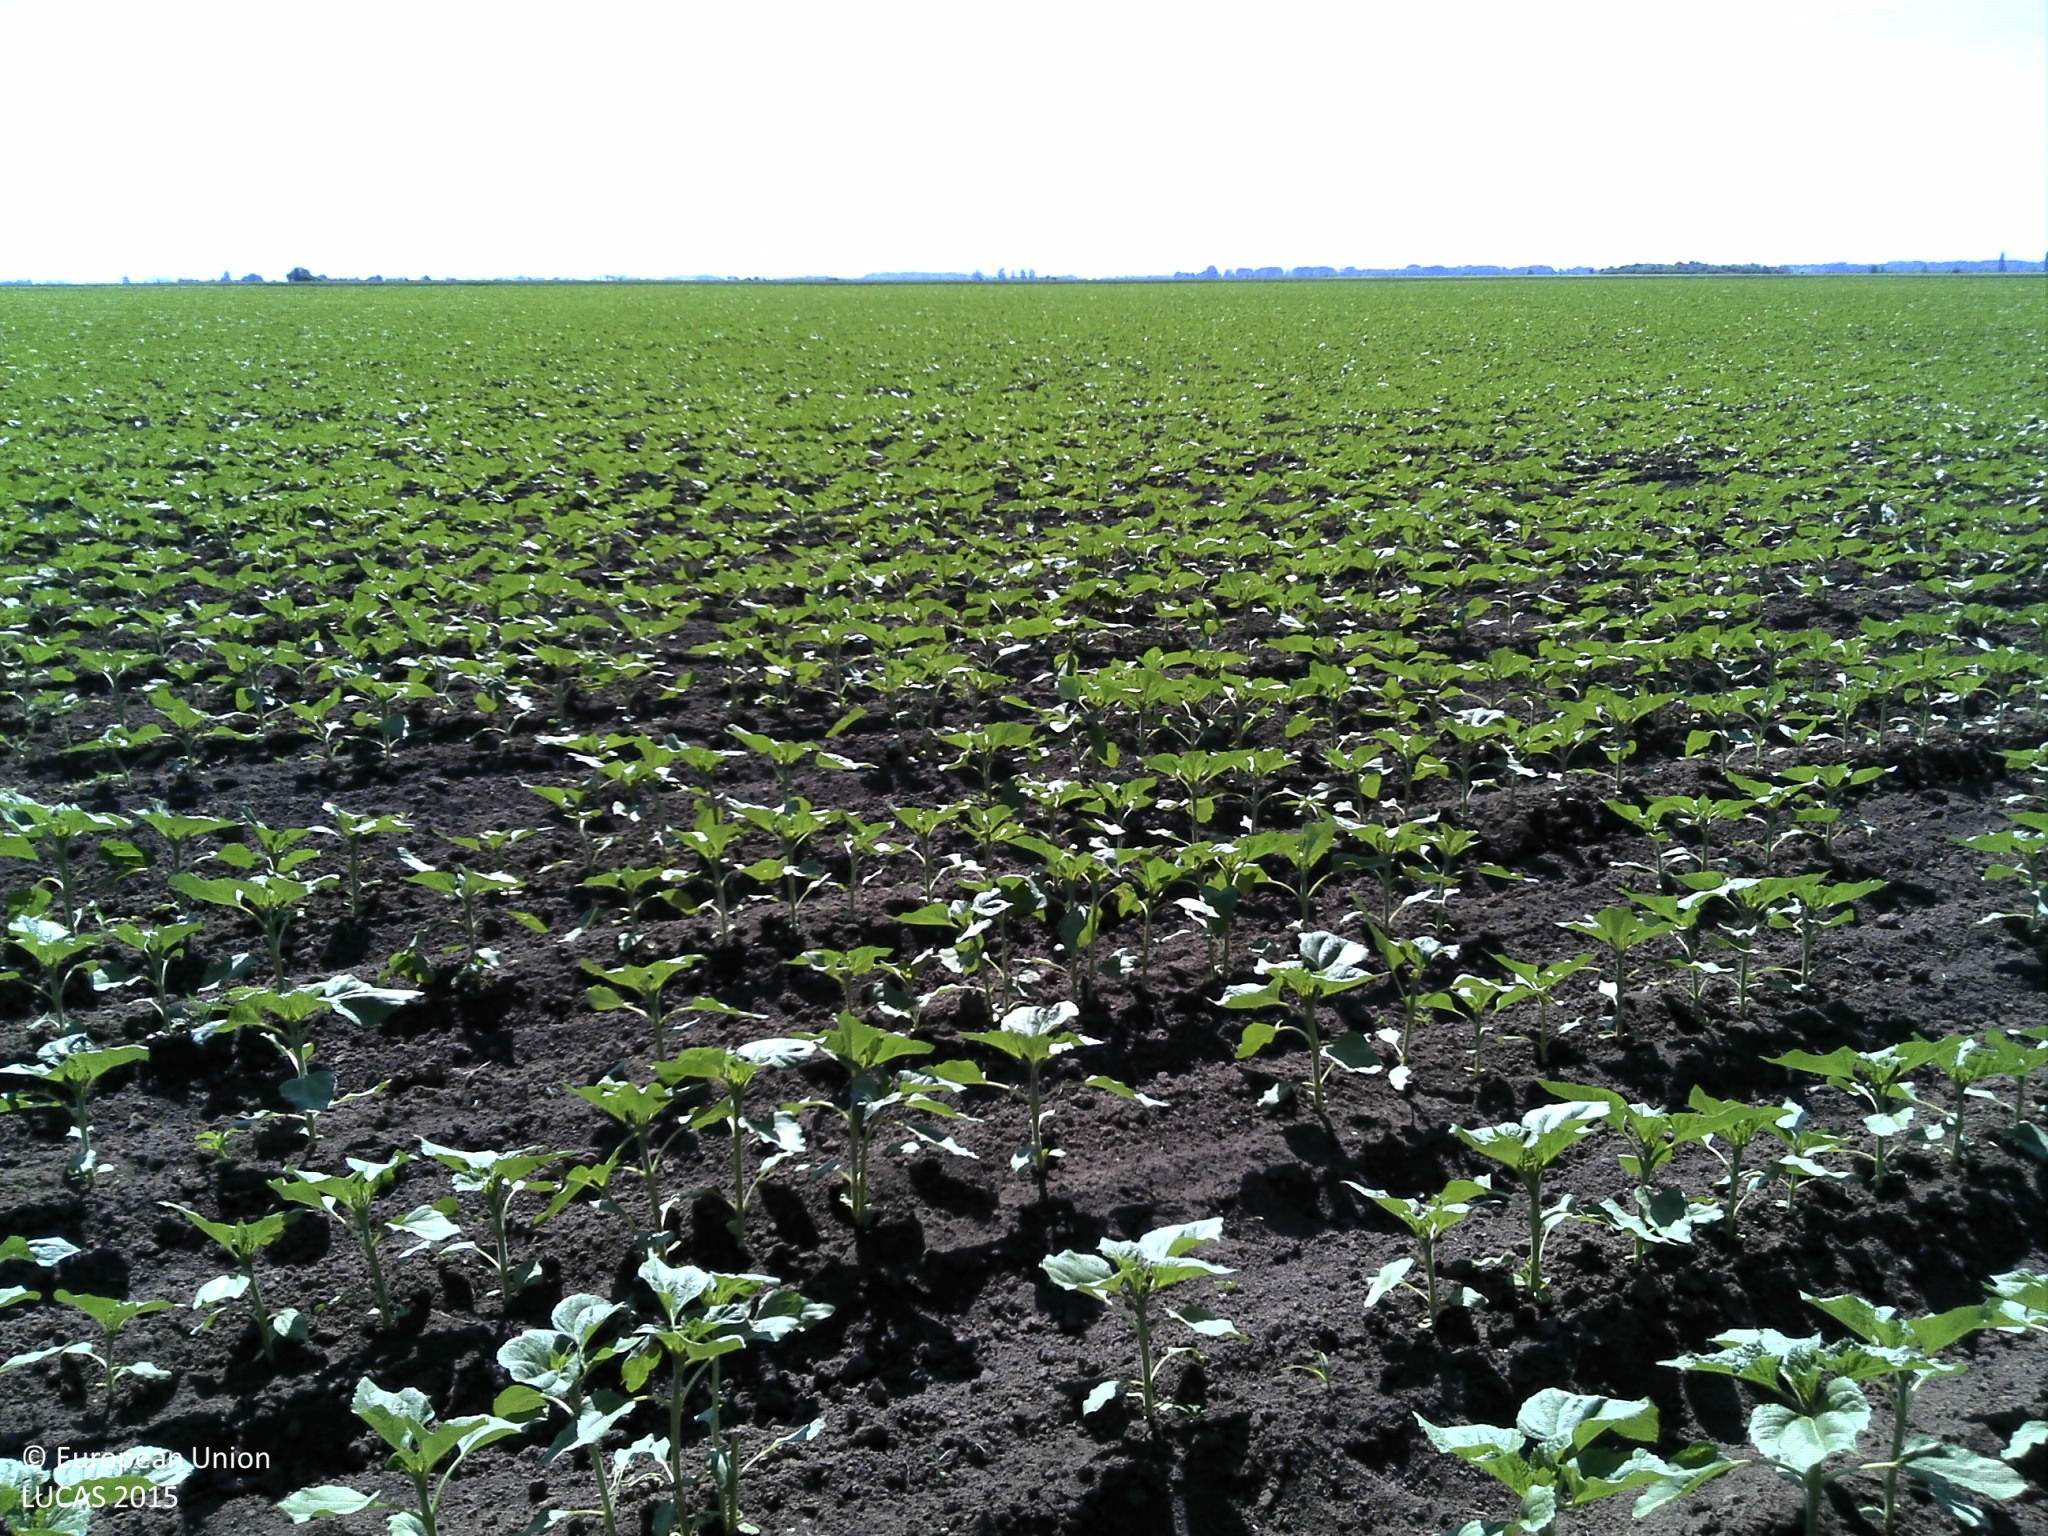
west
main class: Cropland
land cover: Sunflower
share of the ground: 10 - 25 %
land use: Agriculture (excluding fallow land and kitchen gardens)
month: May
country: HR
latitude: 45.8217
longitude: 18.6192
